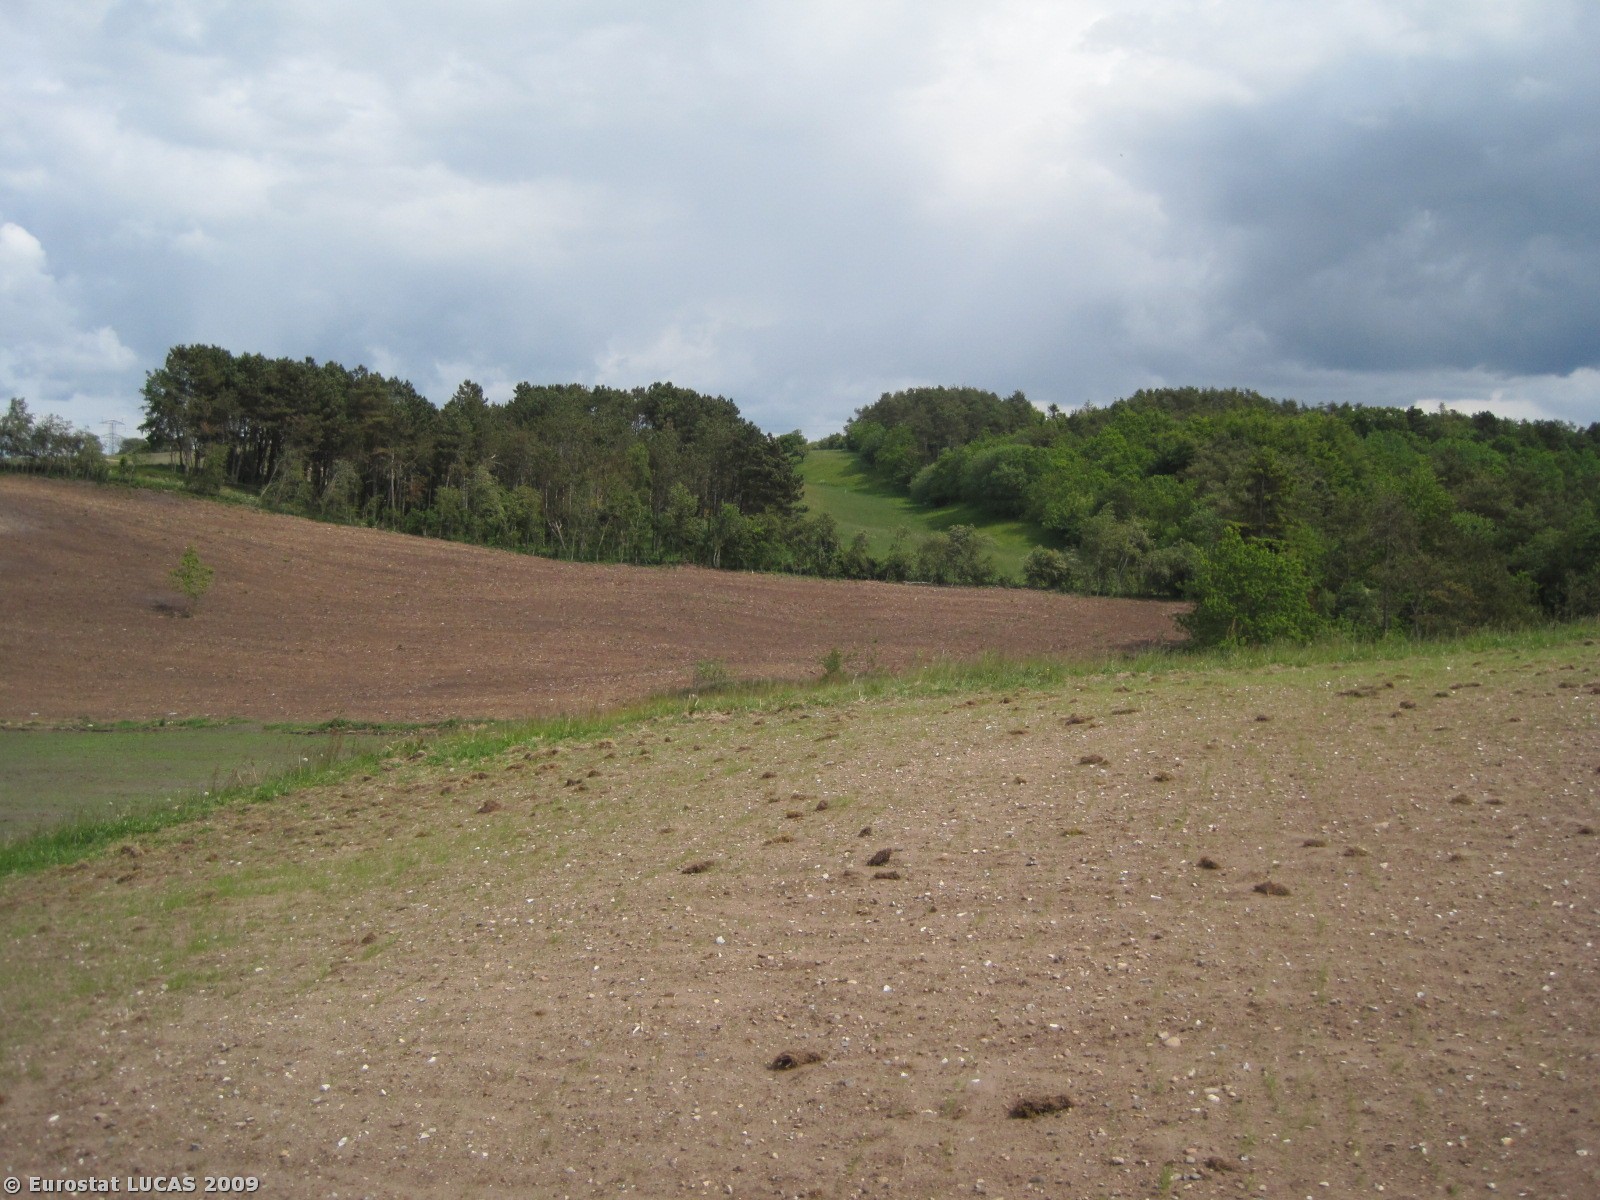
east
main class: Cropland
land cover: Common wheat
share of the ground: < 10 %
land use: Agriculture (excluding fallow land and kitchen gardens)
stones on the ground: 10 - 25 %
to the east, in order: Common wheat; Grassland without tree/shrub cover; Sugar beet; Grassland without tree/shrub cover; Bare land; Broadleaved woodland; Fences; Grassland without tree/shrub cover
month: June
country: DK
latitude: 56.8885
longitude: 9.6886
